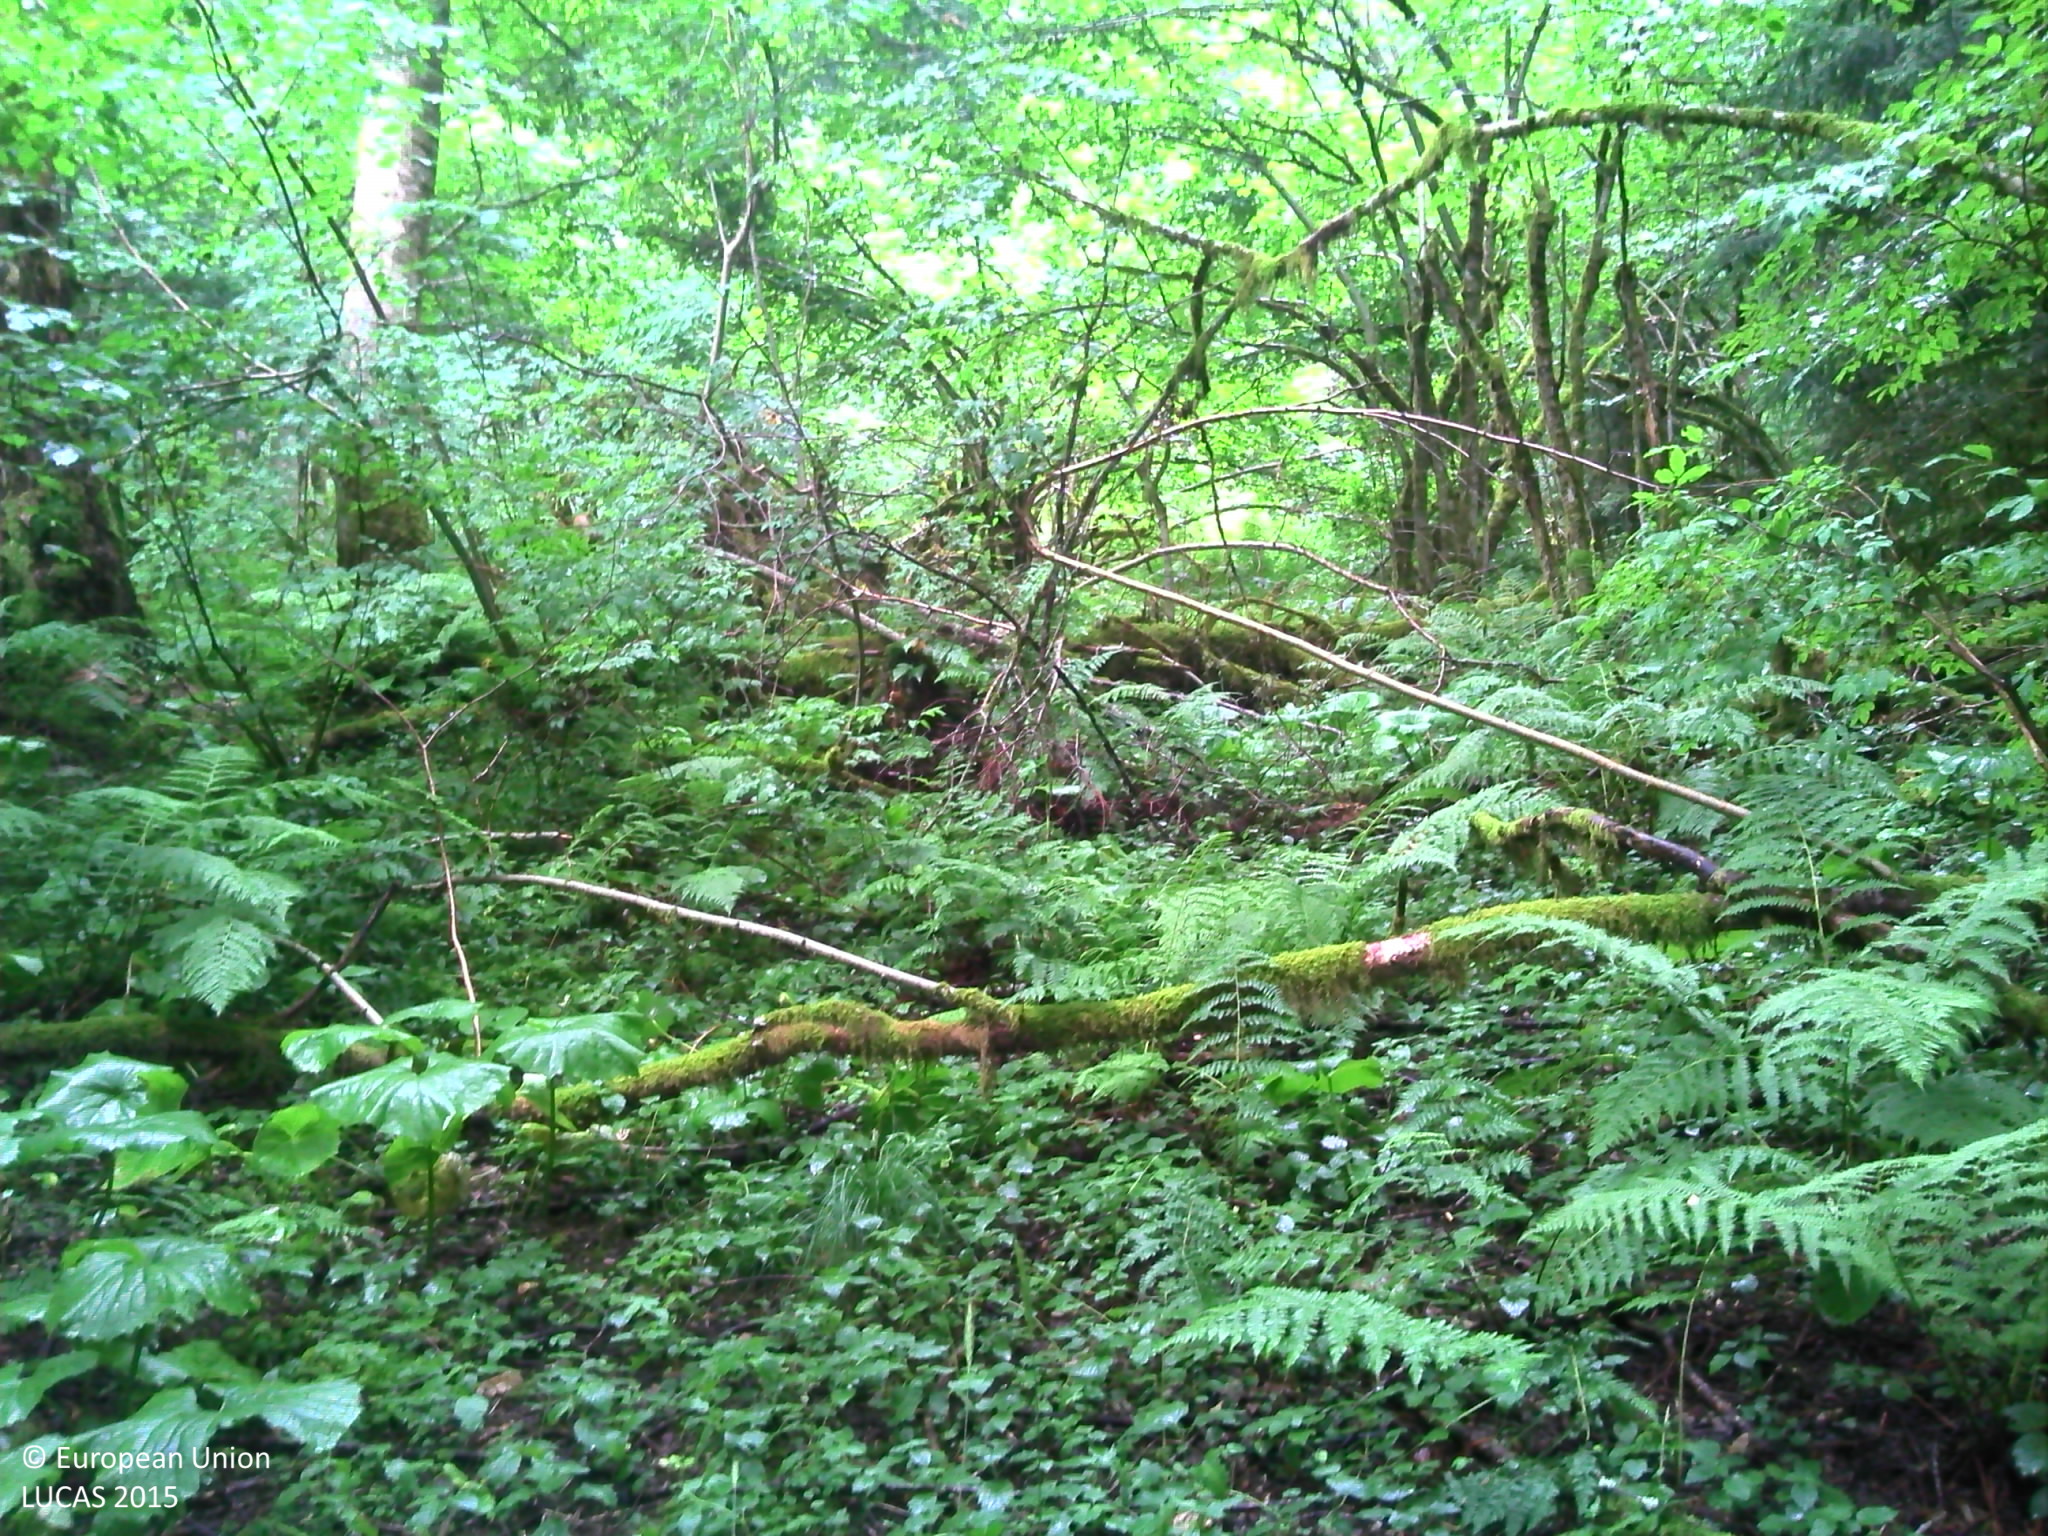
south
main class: Woodland
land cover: Spruce dominated coniferous woodland
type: alpine coniferous forest
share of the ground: > 75 %
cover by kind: coniferous forest trees 65 %, broadleaved forest trees 15 %, herbaceous plants 15 %, lichens and mosses 5 %
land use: Forestry
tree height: > 5 m
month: July
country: FR
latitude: 46.0175
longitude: 6.3226
